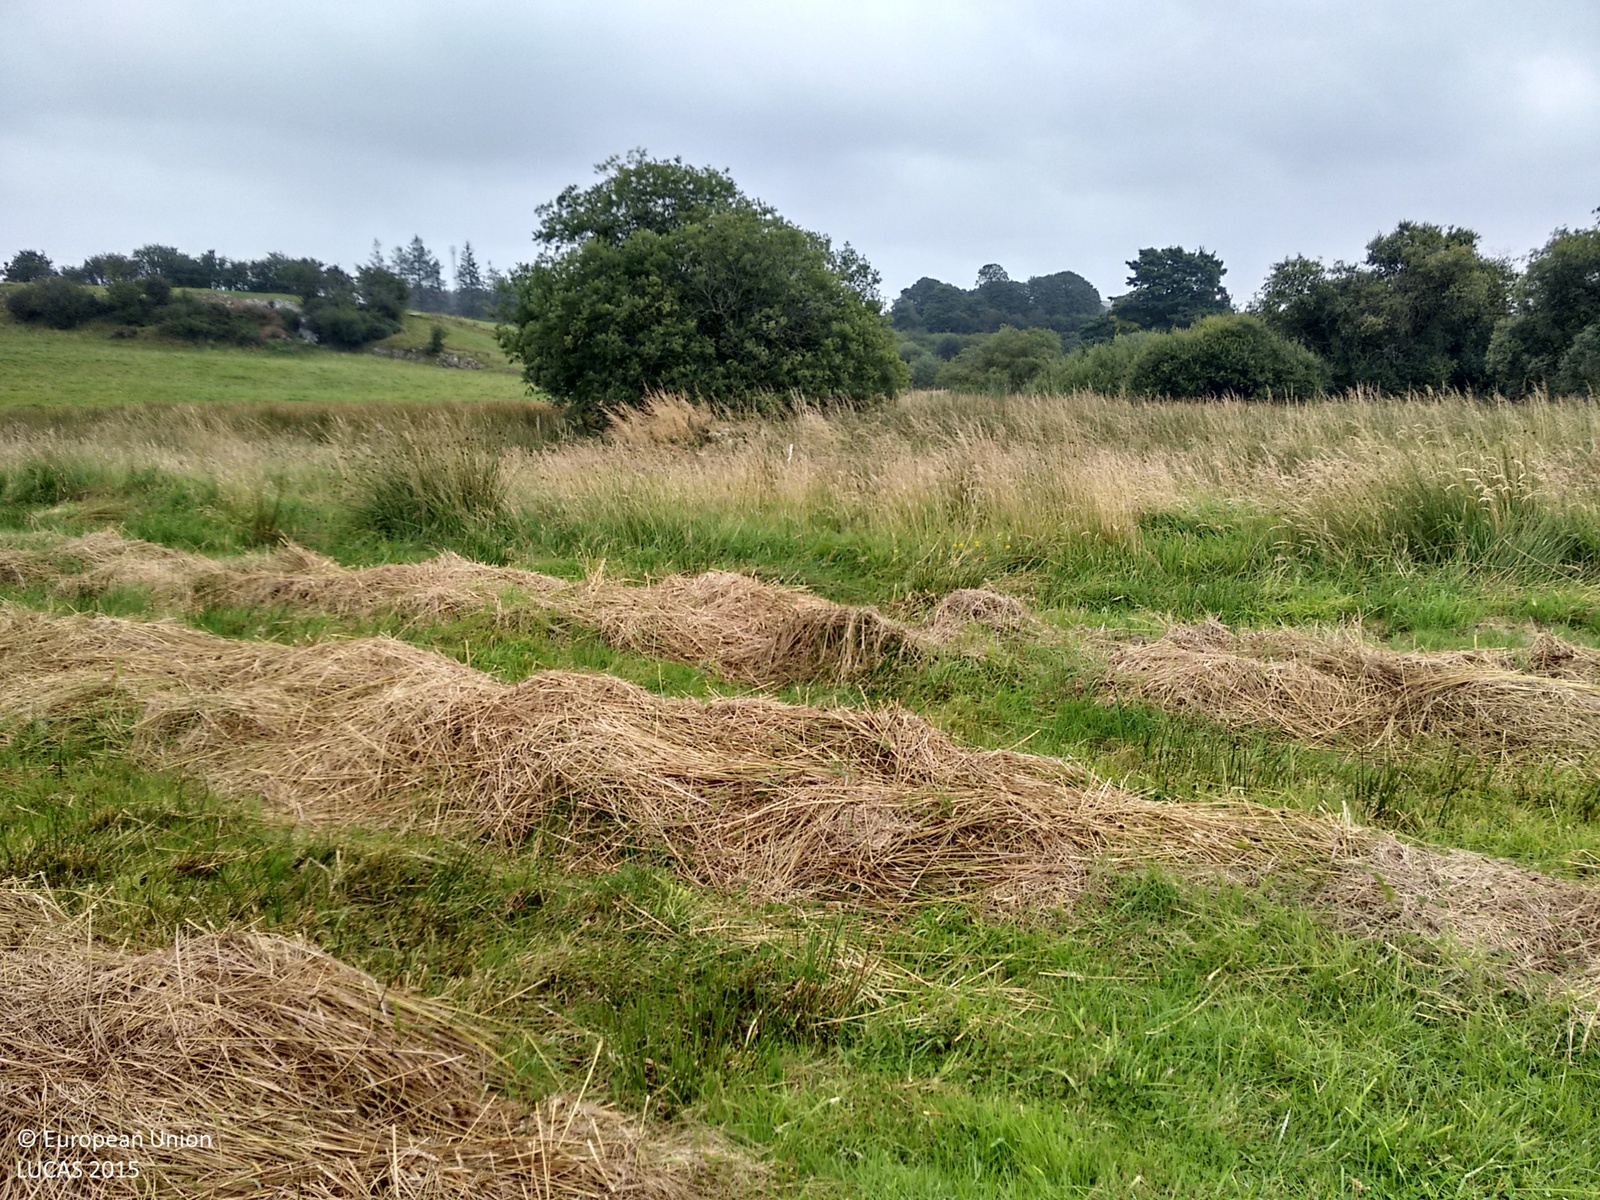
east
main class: Grassland
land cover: Grassland without tree/shrub cover
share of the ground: > 75 %
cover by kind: herbaceous plants 100 %
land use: Agriculture (excluding fallow land and kitchen gardens)
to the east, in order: Grassland without tree/shrub cover; Fences; Ditches and canals; Spontaneously vegetated surfaces; Fences; Inland marshes; Electric lines; Grassland without tree/shrub cover; Fences; Grassland without tree/shrub cover; Fences; Managed hedges; Spontaneously vegetated surfaces
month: August
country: IE
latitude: 54.0553
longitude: -6.8005
